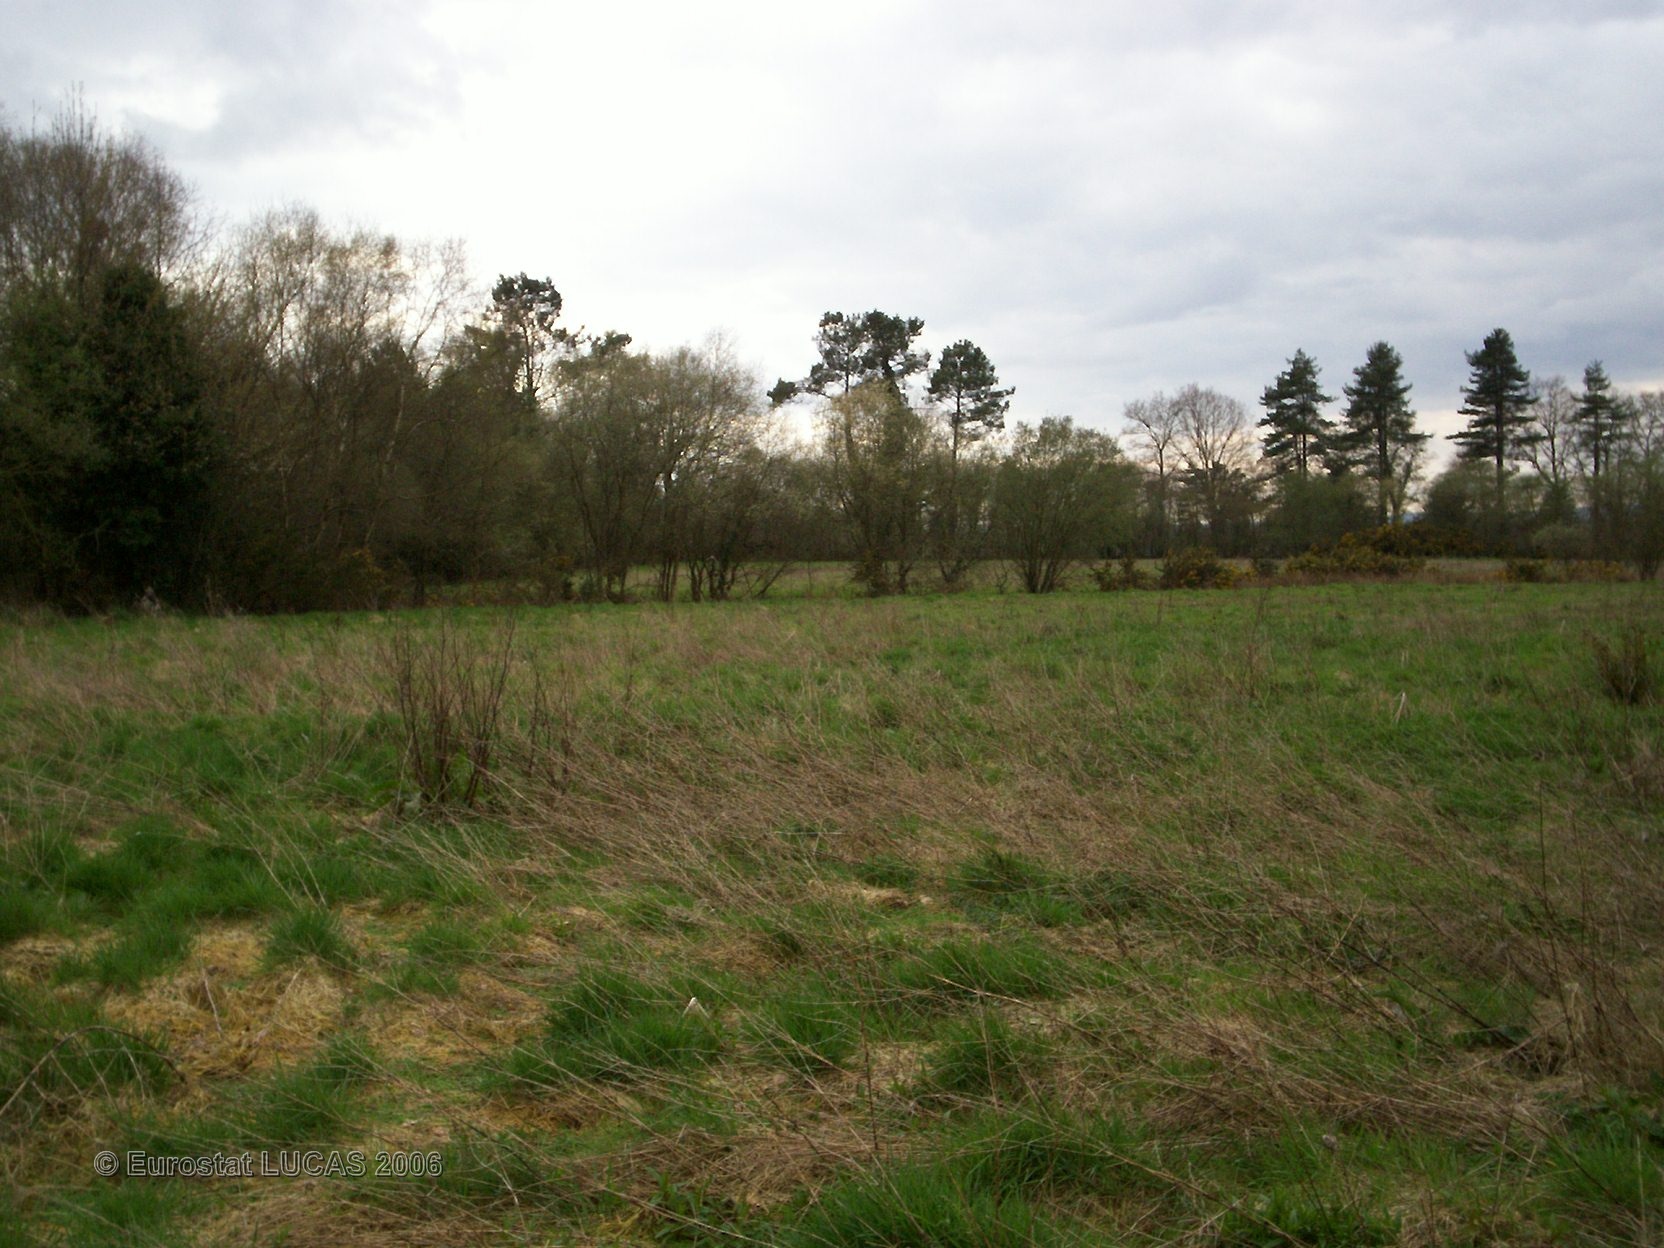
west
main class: Grassland
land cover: Grassland without tree/shrub cover
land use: Fallow land
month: April
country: FR
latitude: 48.1360
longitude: -2.8999
